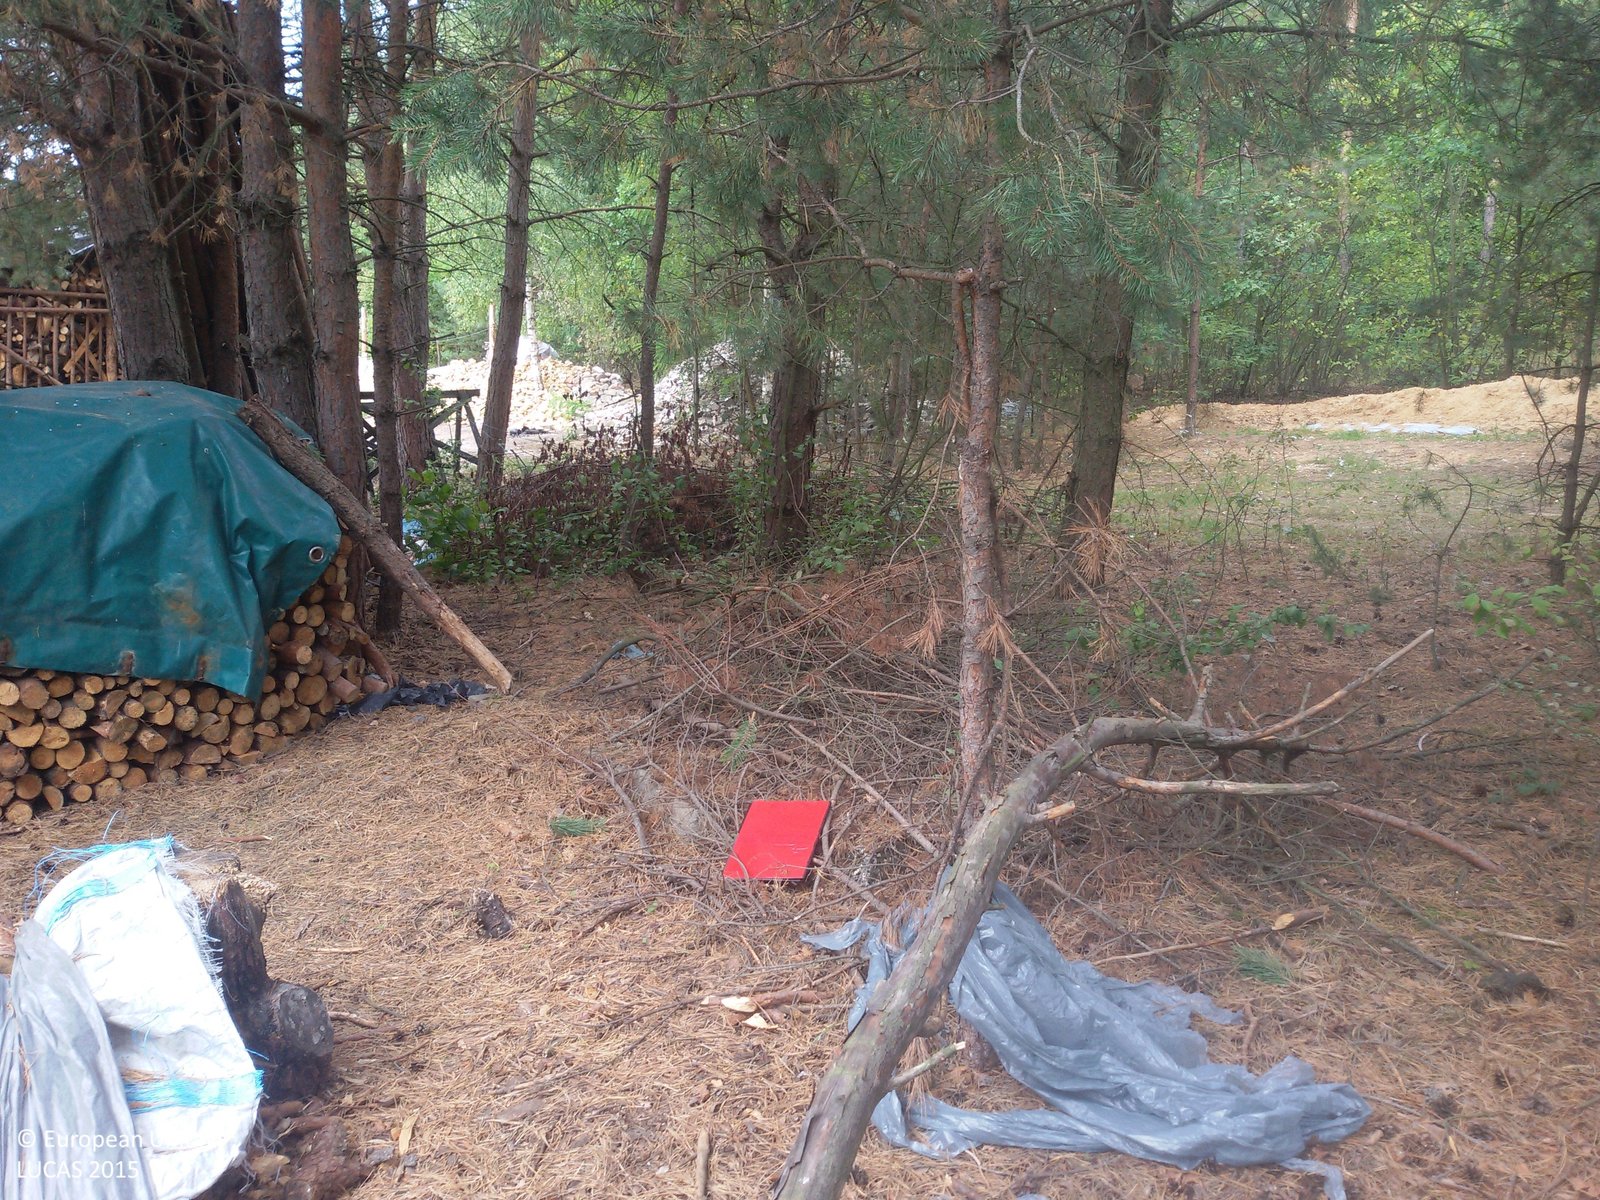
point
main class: Woodland
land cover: Pine dominated coniferous woodland
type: hemiboreal forest and nemoral coniferous forest and mixed broadleaved-coniferous forest
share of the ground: > 75 %
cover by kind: coniferous forest trees 70 %, herbaceous plants 20 %, lichens and mosses 10 %
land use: Forestry
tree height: > 5 m
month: September
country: PL
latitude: 51.0914
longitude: 18.8026
